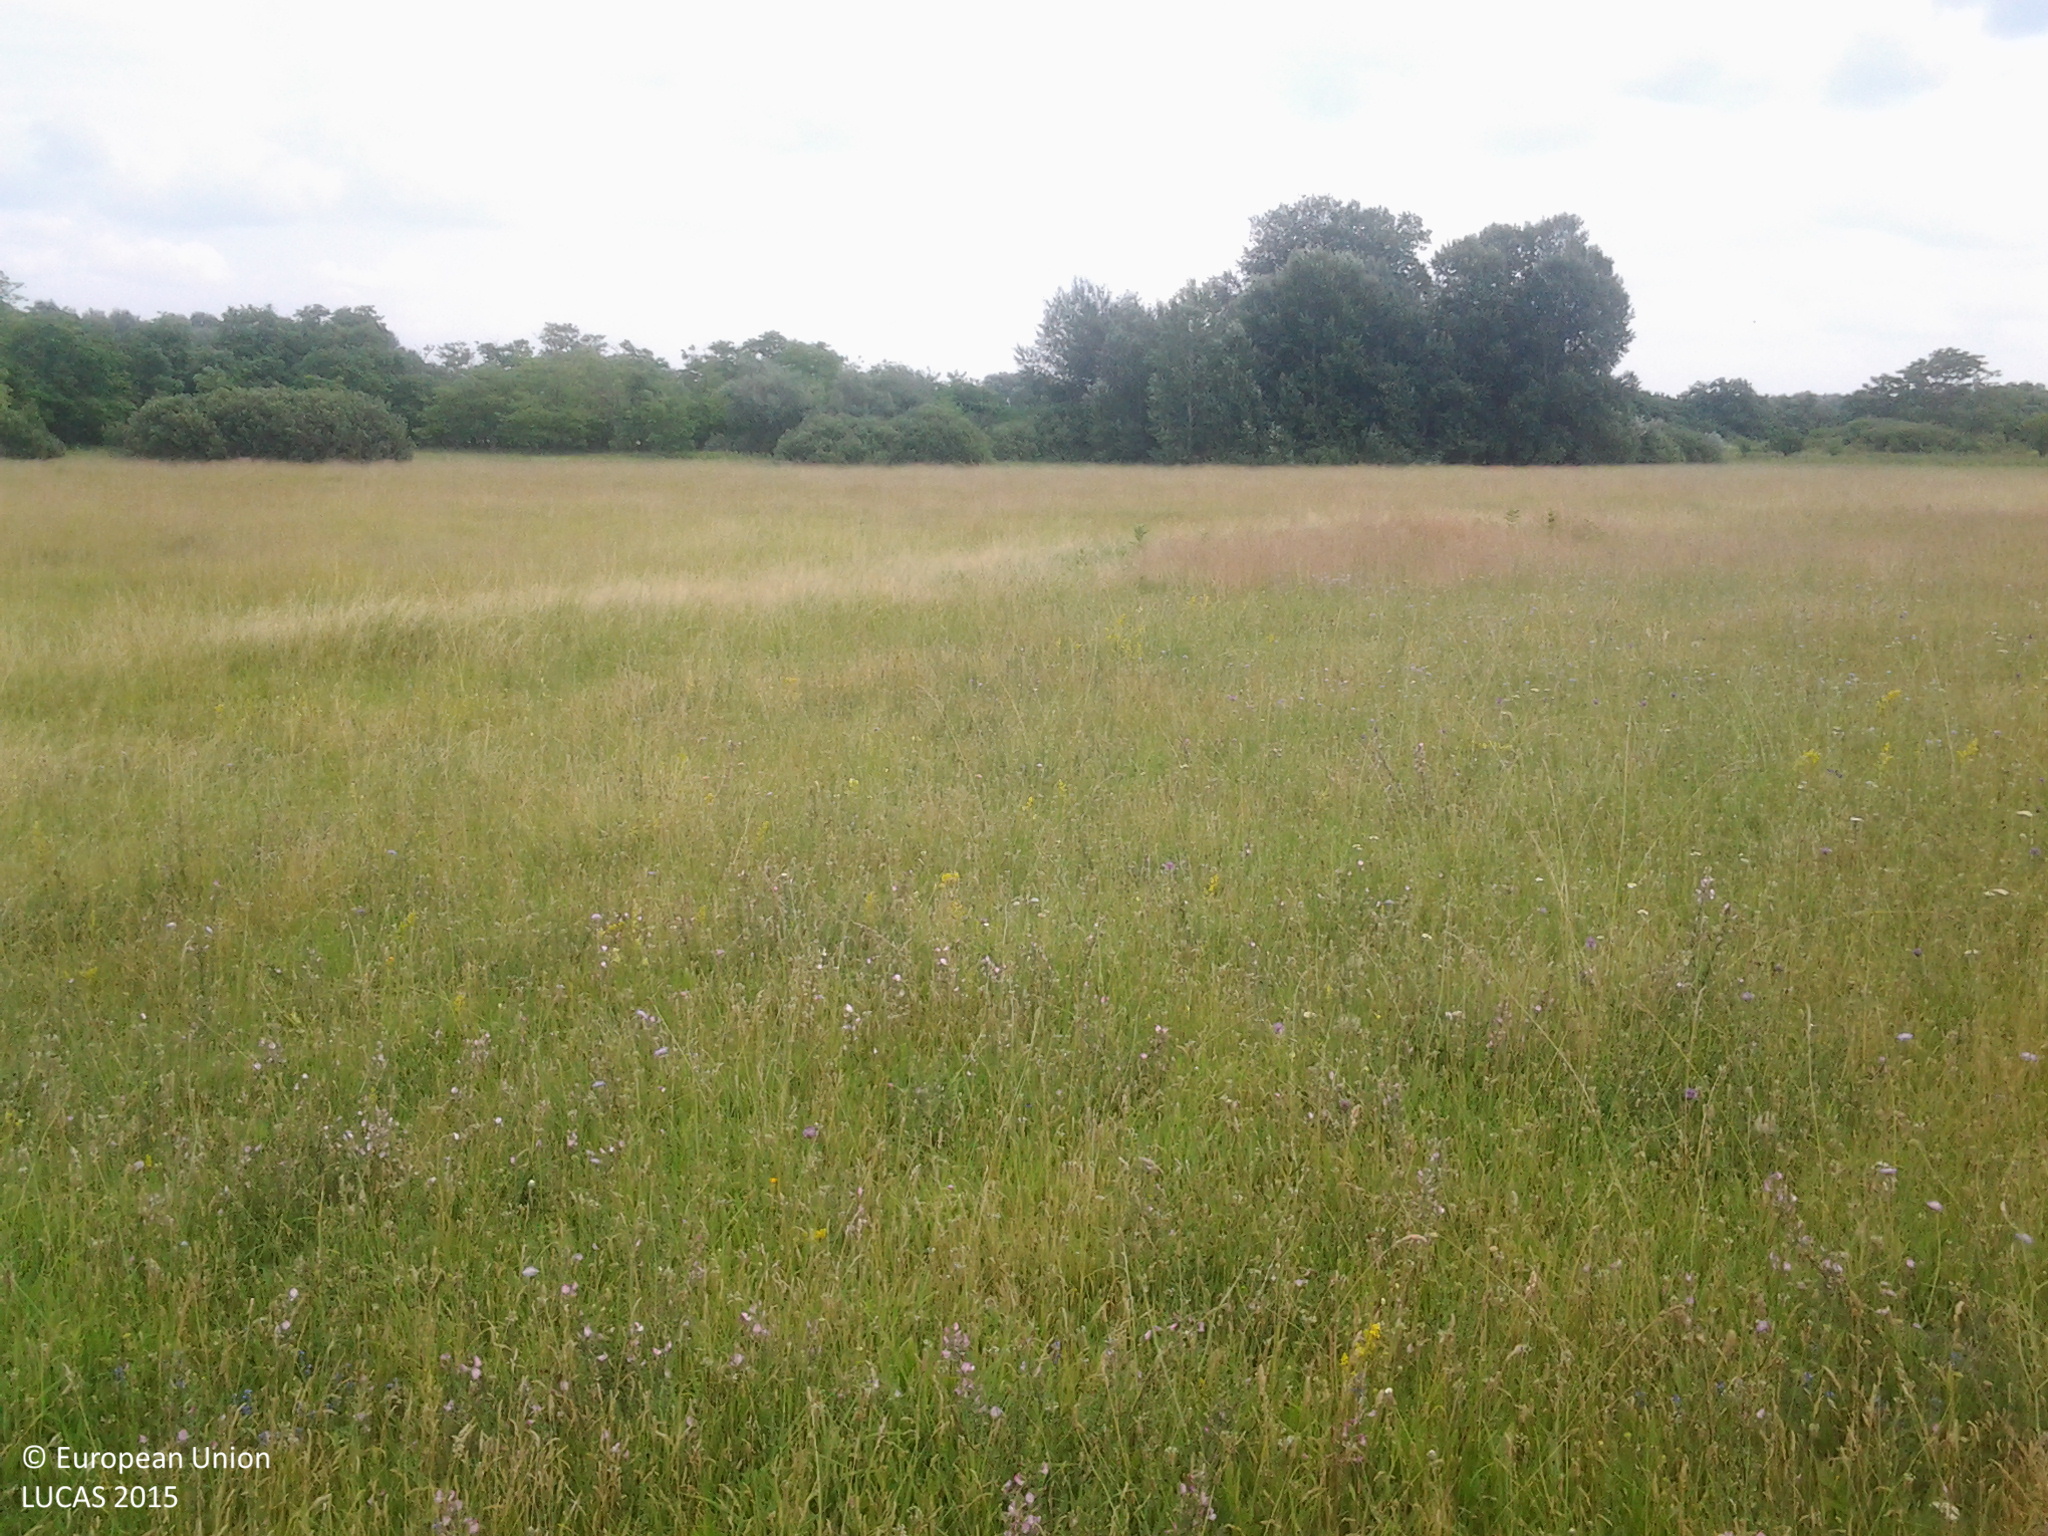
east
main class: Grassland
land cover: Spontaneously vegetated surfaces
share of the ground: > 75 %
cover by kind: herbaceous plants 100 %
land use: Semi-natural and natural areas not in use
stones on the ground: < 10 %
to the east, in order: Spontaneously vegetated surfaces; Broadleaved woodland; Grass margins; Tracks; Grass margins; Electric lines; Spontaneously vegetated surfaces
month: June
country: HU
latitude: 46.7988
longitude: 19.2801
